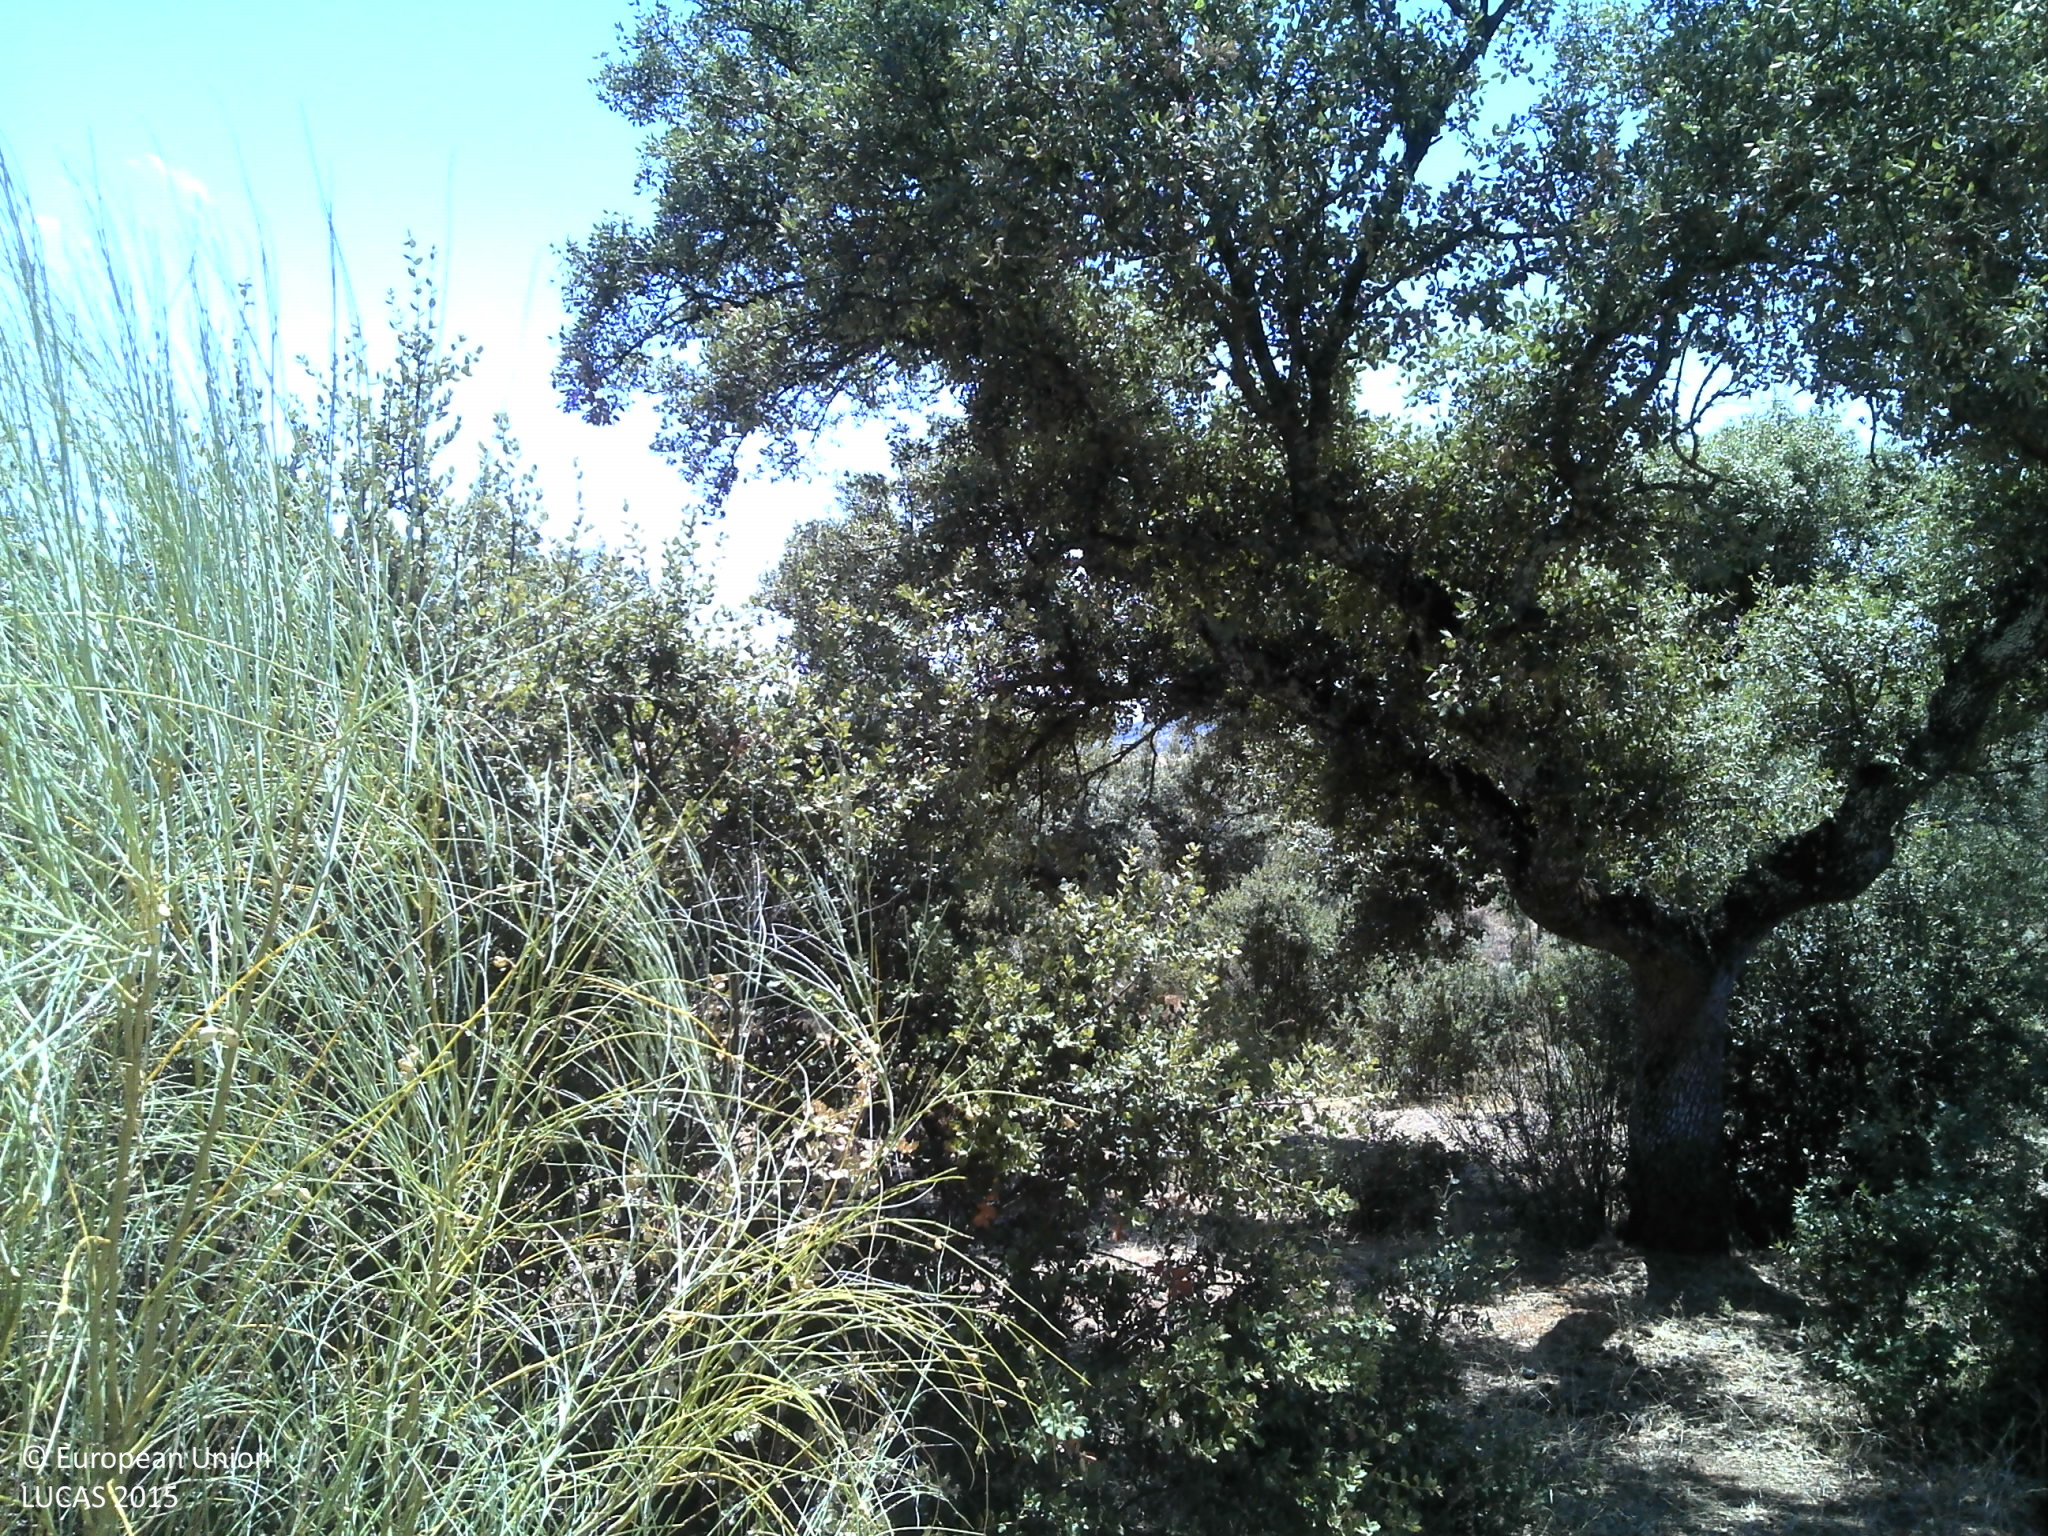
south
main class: Woodland
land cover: Broadleaved woodland
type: broadleaved evergreen forest
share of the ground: 25 - 50 %
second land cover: Shrubland without tree cover
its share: 50 - 75 %
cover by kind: shrubs 50 %, broadleaved forest trees 30 %, unconsolidated bare surface 20 %
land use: Forestry
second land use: Agriculture (excluding fallow land and kitchen gardens)
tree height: > 5 m
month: July
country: PT
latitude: 38.8367
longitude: -7.2519
